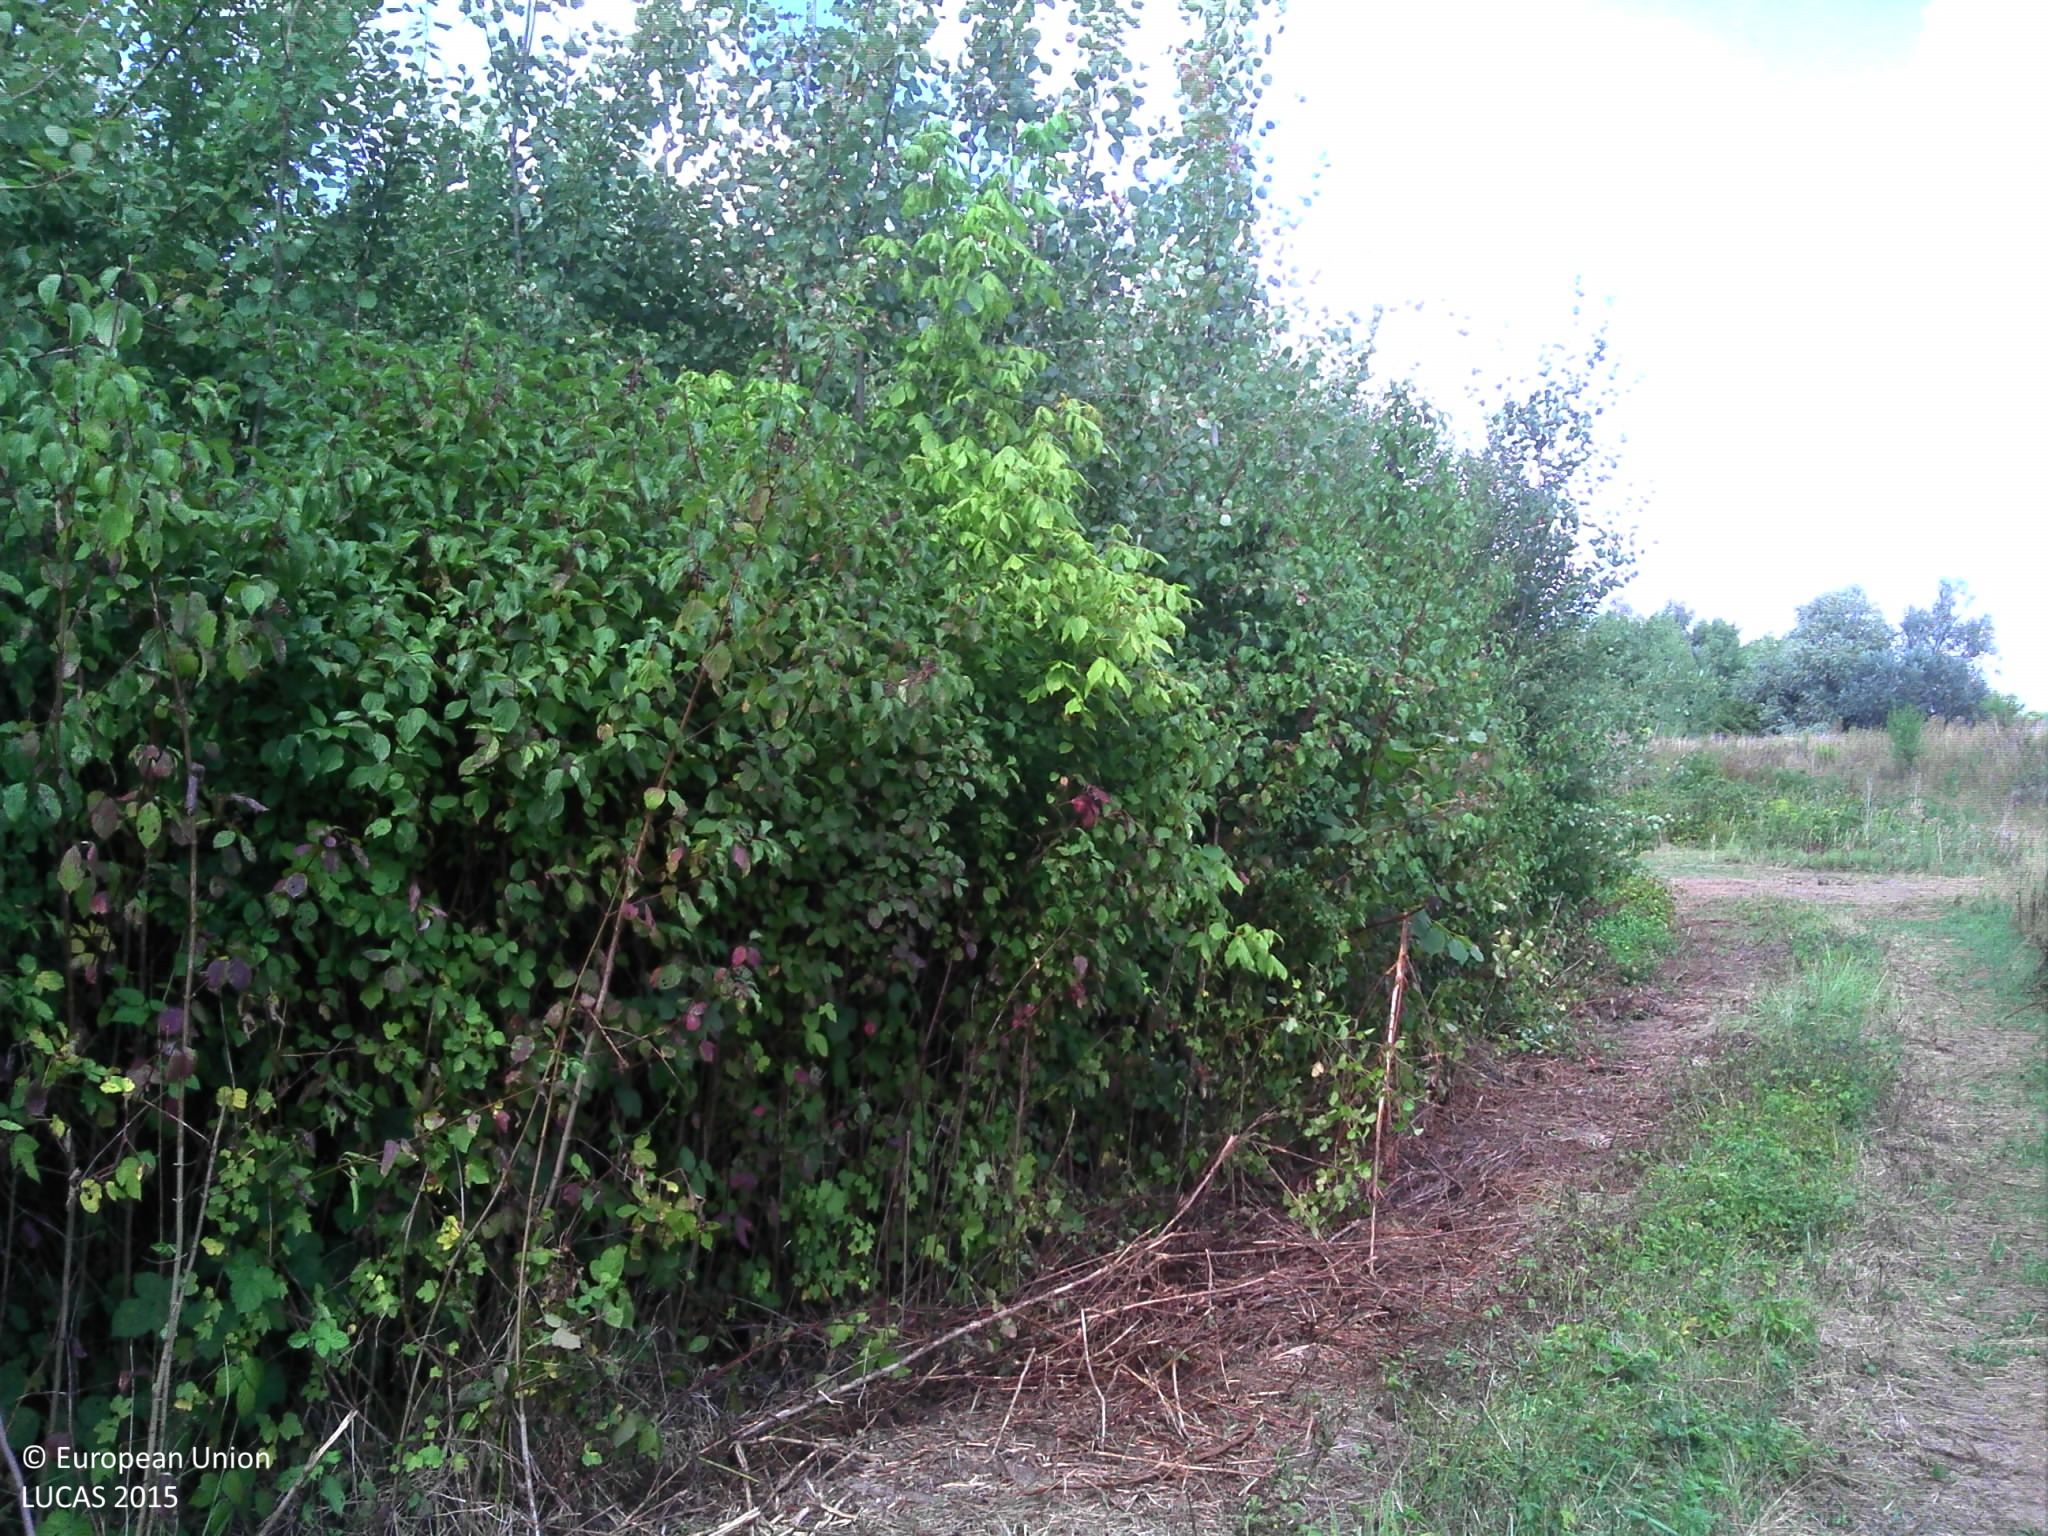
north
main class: Grassland
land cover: Spontaneously vegetated surfaces
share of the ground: > 75 %
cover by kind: herbaceous plants 85 %, lichens and mosses 5 %
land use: Semi-natural and natural areas not in use
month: August
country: FR
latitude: 48.8824
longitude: 2.6667
